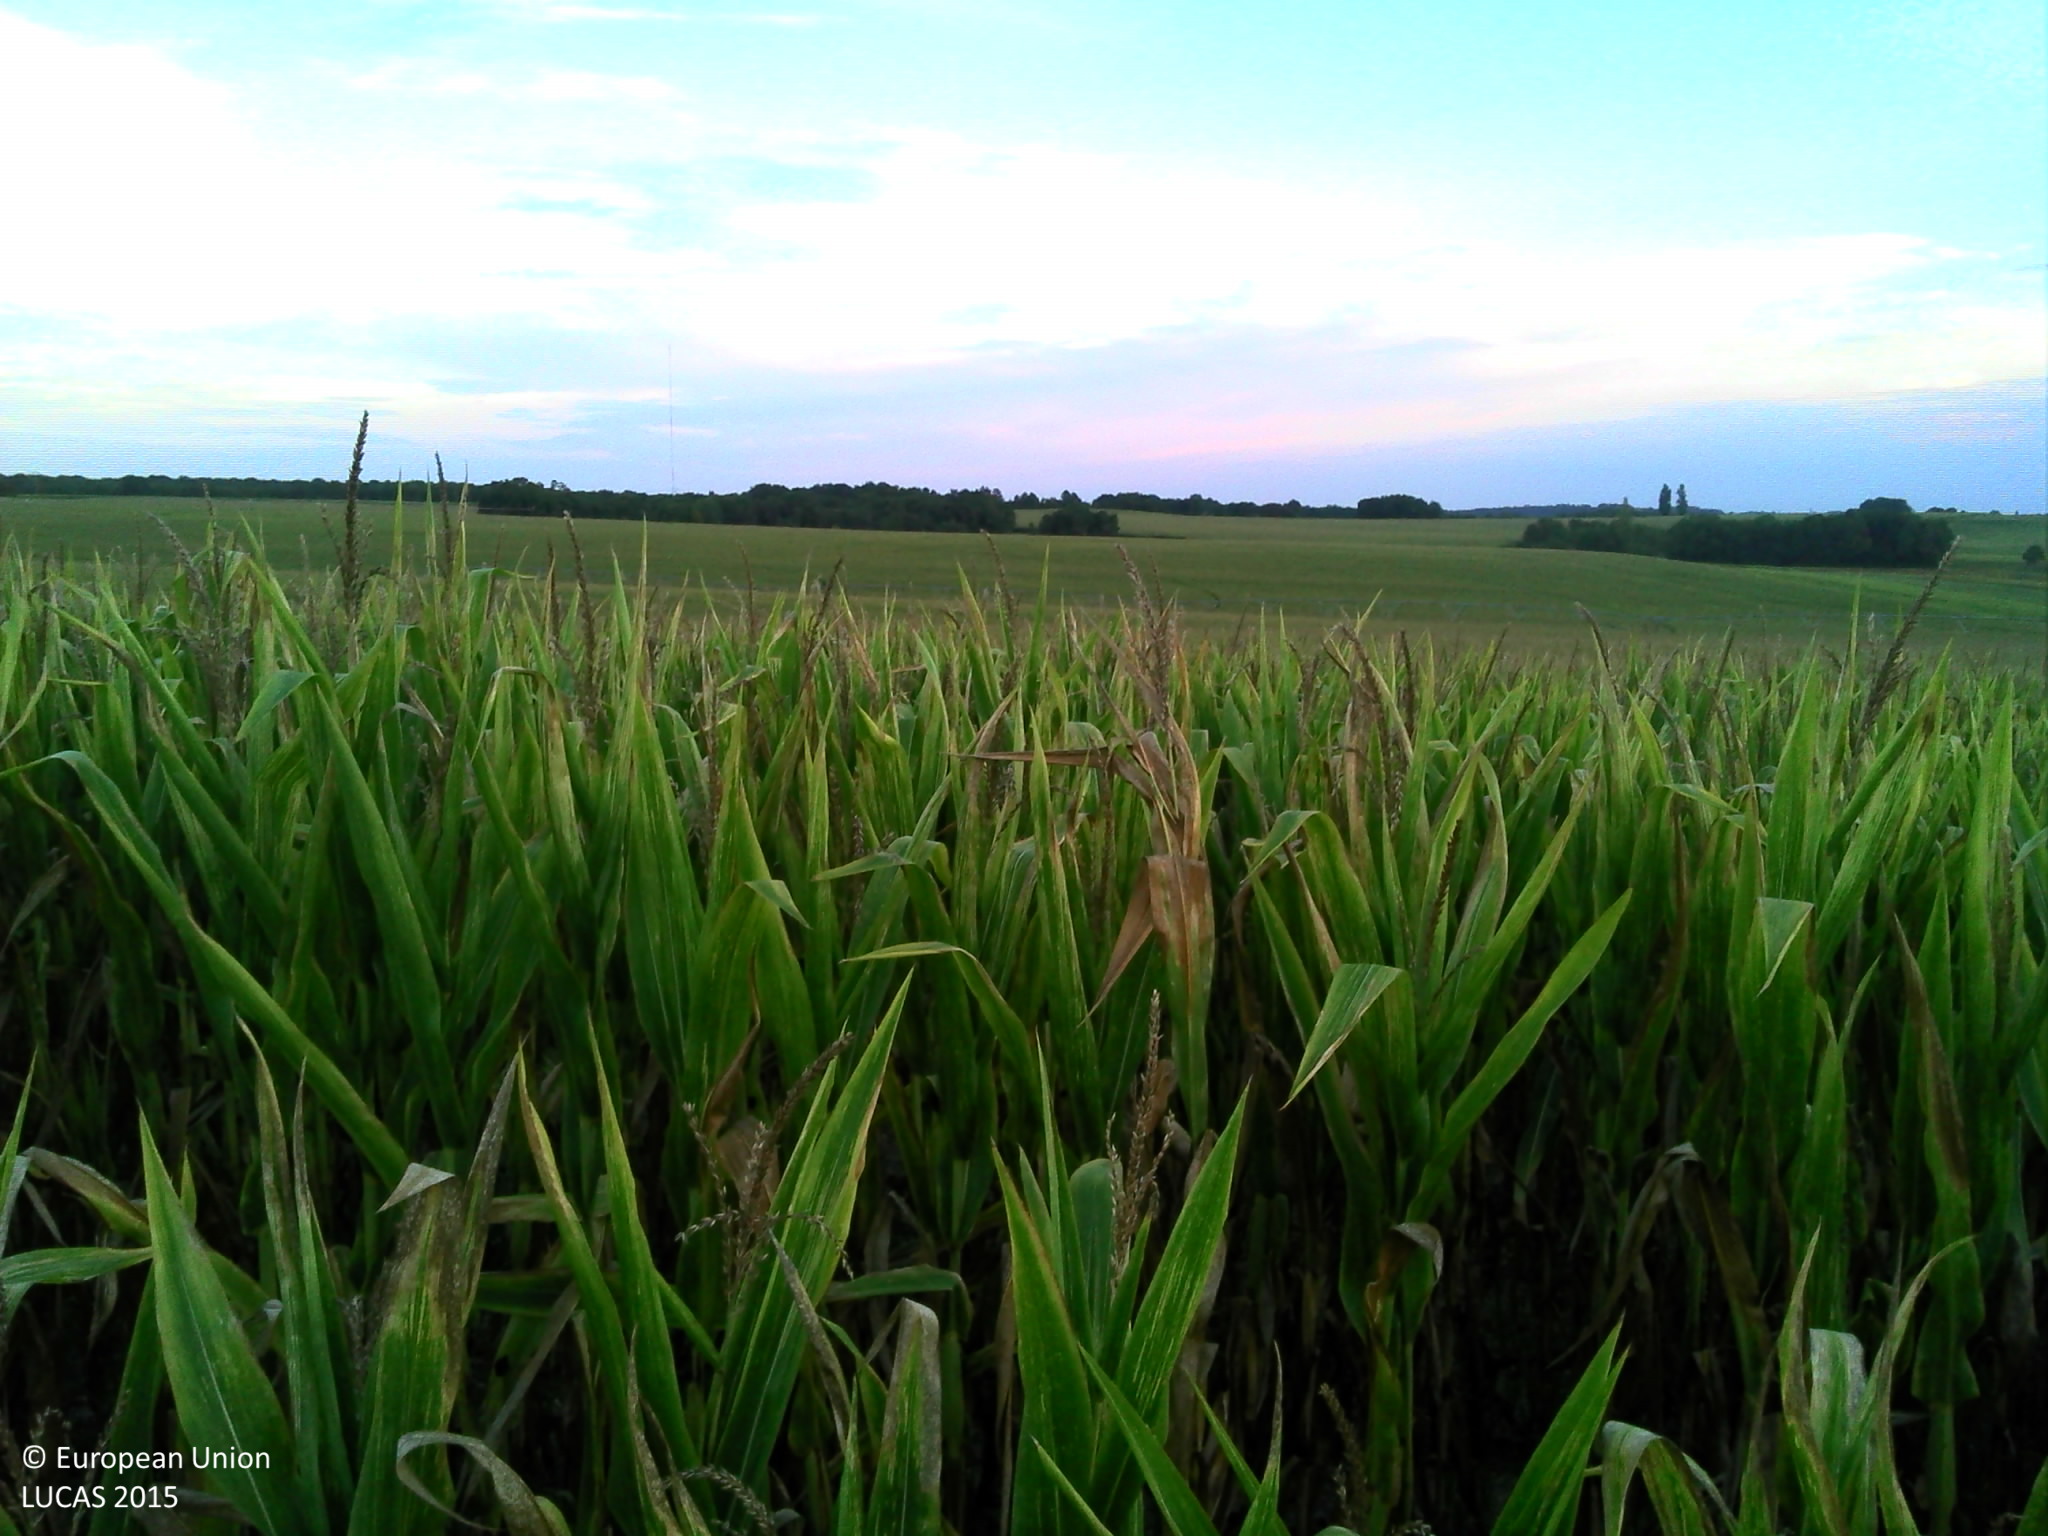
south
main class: Cropland
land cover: Maize
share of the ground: > 75 %
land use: Agriculture (excluding fallow land and kitchen gardens)
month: August
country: FR
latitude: 45.3741
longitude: 0.3972
